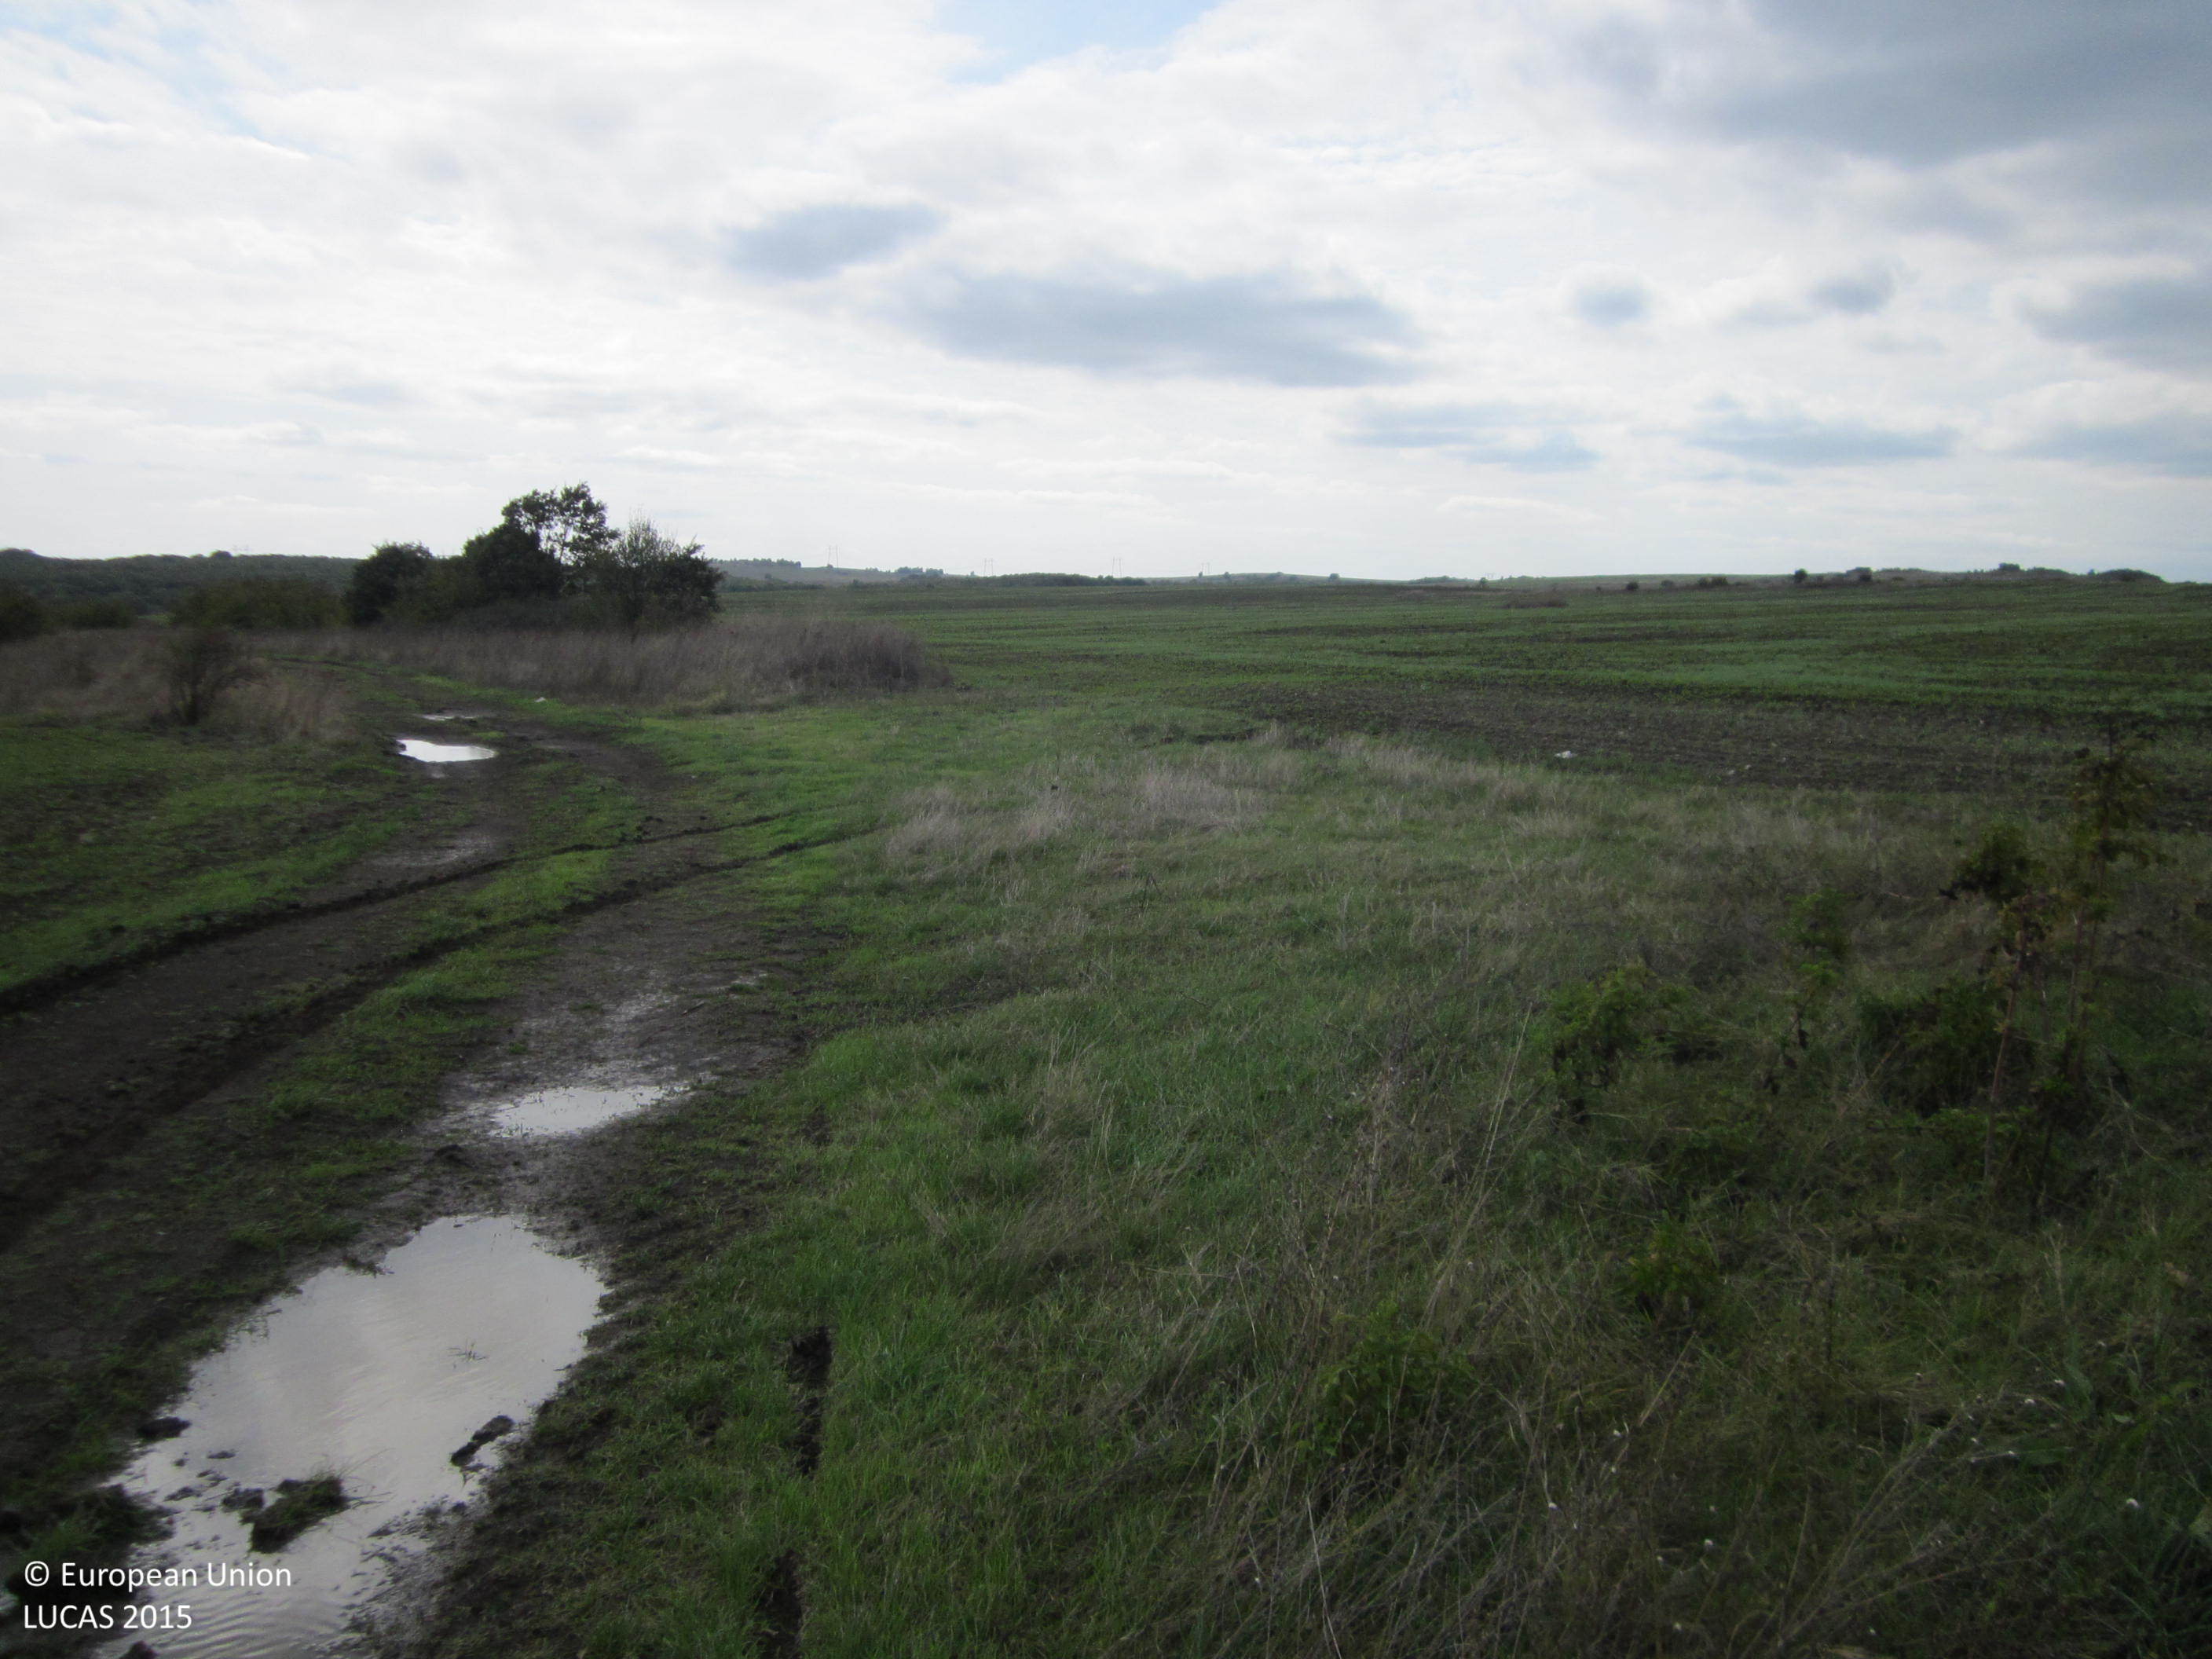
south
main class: Grassland
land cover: Spontaneously vegetated surfaces
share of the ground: > 75 %
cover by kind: herbaceous plants 100 %
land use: Fallow land
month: October
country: BG
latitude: 42.3442
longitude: 27.0117
